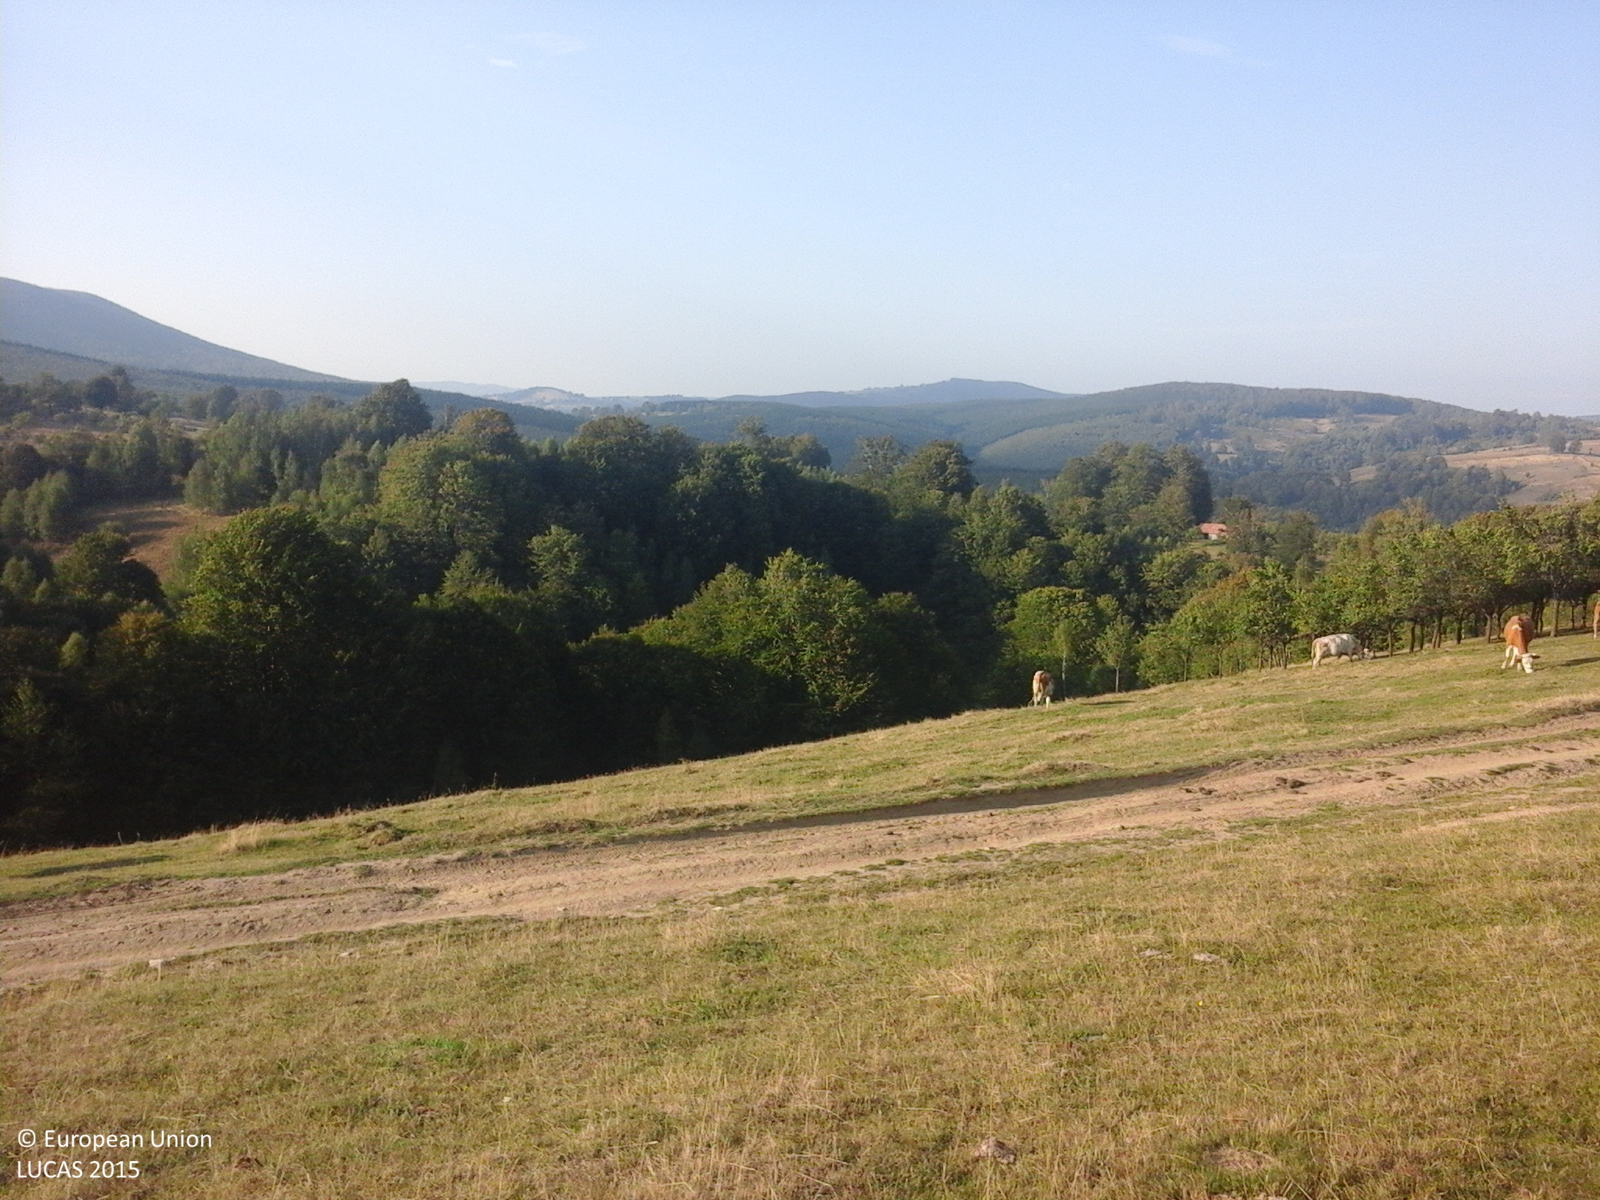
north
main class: Grassland
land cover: Grassland without tree/shrub cover
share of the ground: > 75 %
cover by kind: herbaceous plants 100 %
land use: Agriculture (excluding fallow land and kitchen gardens)
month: September
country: RO
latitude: 45.1596
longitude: 22.1876
